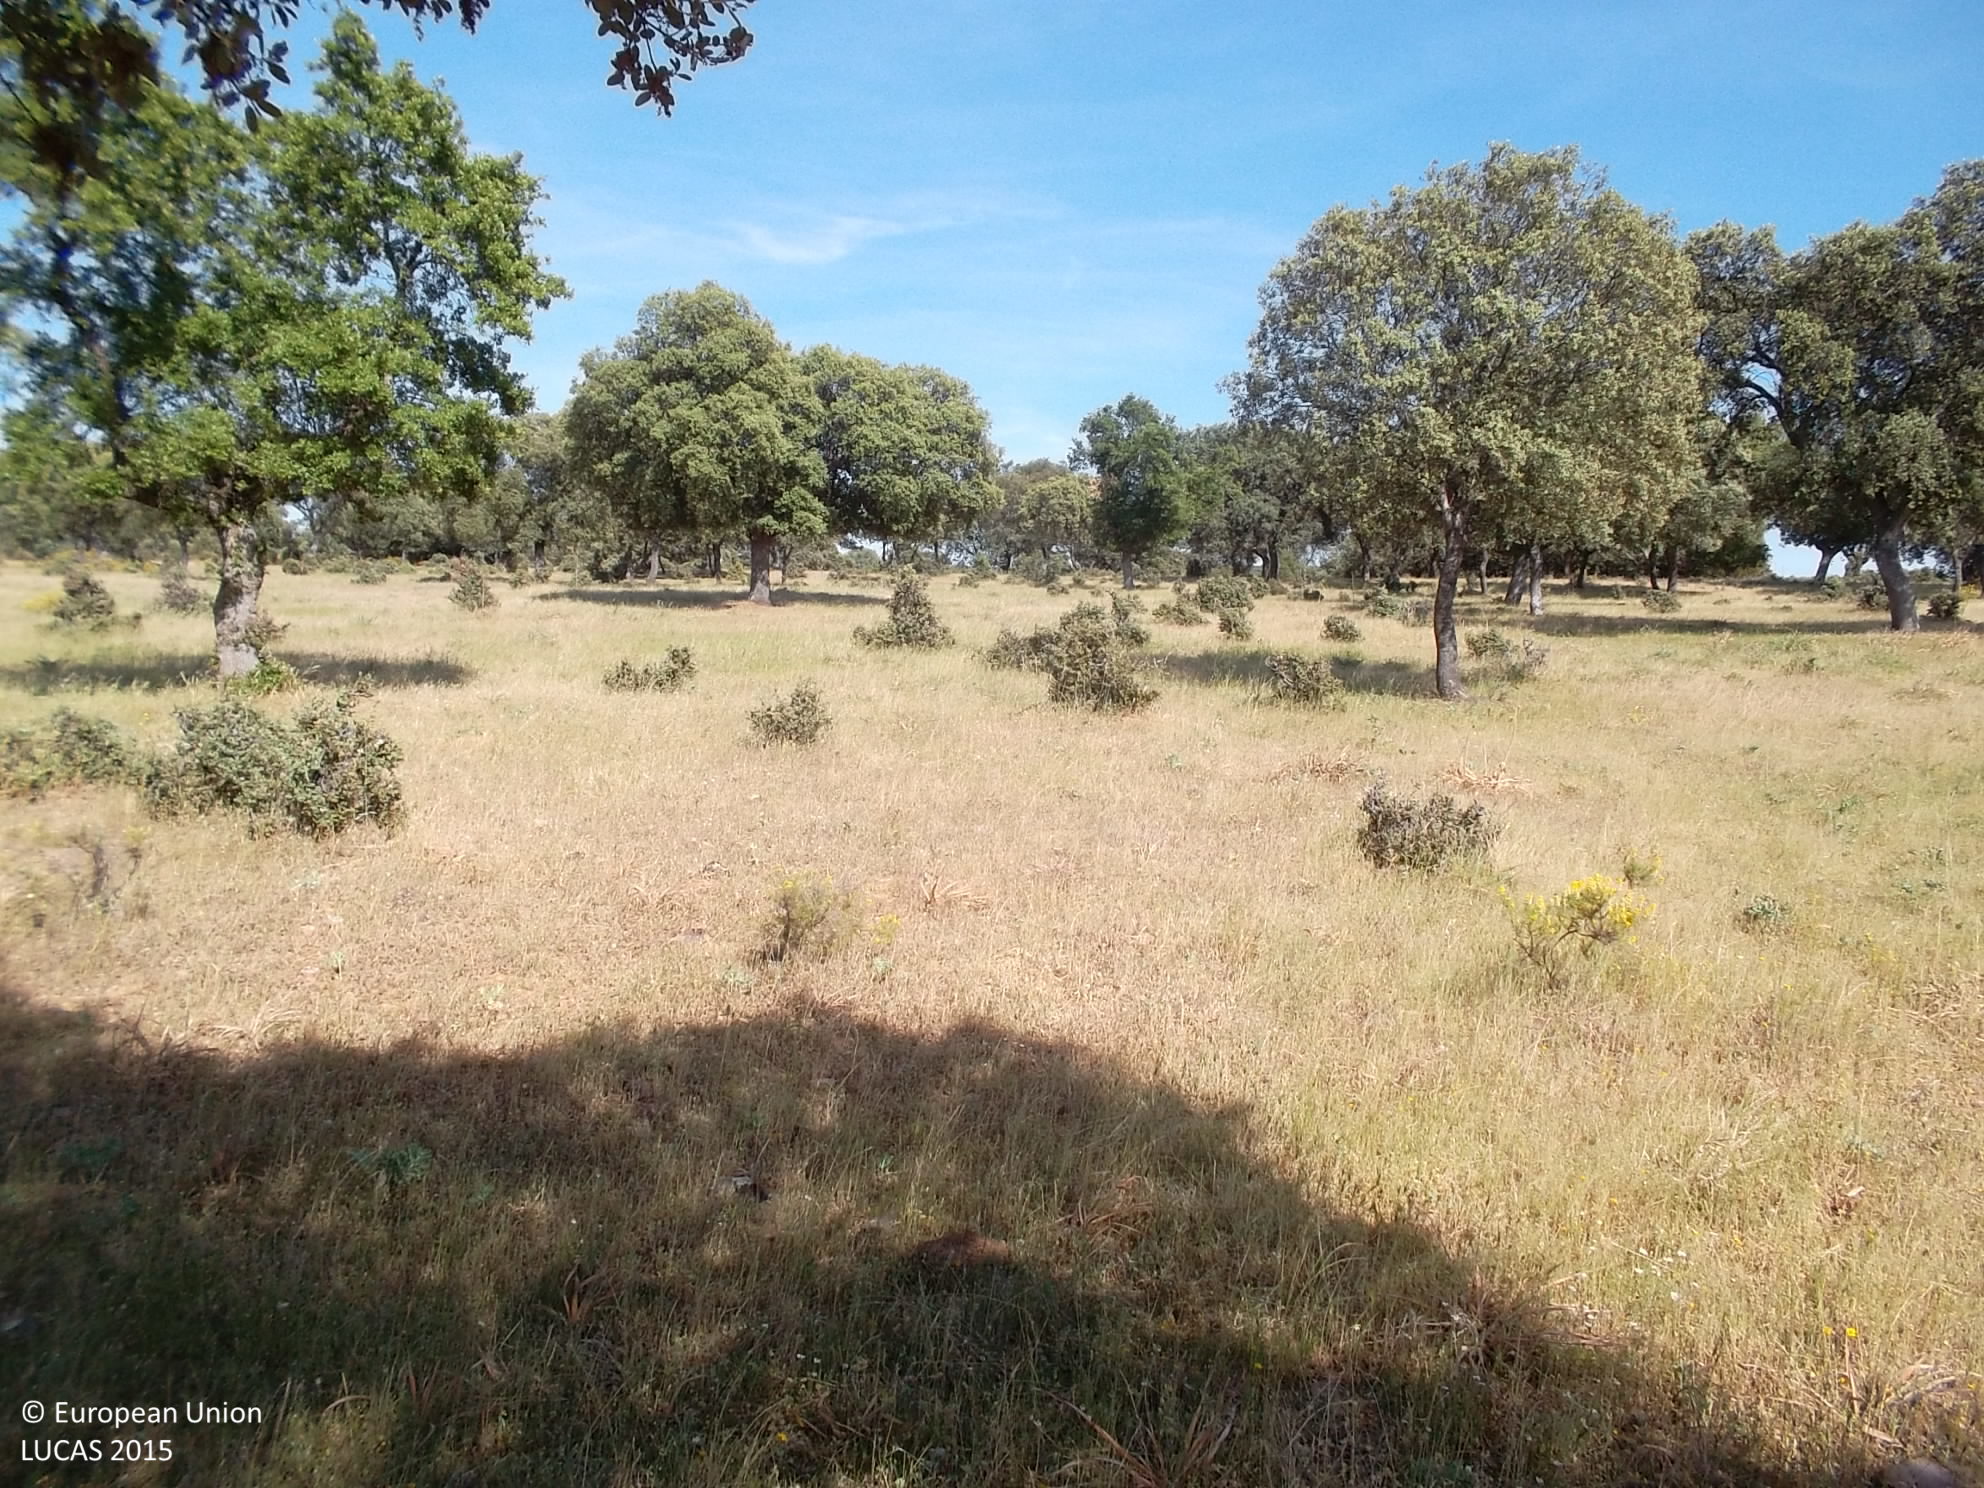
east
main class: Woodland
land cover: Broadleaved woodland
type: broadleaved evergreen forest
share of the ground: 25 - 50 %
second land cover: Spontaneously vegetated surfaces
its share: > 75 %
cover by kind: herbaceous plants 60 %, broadleaved forest trees 40 %
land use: Forestry
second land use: Agriculture (excluding fallow land and kitchen gardens)
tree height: > 5 m
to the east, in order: Broadleaved woodland; Spontaneously vegetated surfaces; Fences; Broadleaved woodland; Fences; Grassland without tree/shrub cover; Fences; Grass margins; Tracks; Broadleaved woodland
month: May
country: ES
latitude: 38.7985
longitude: -4.4984
